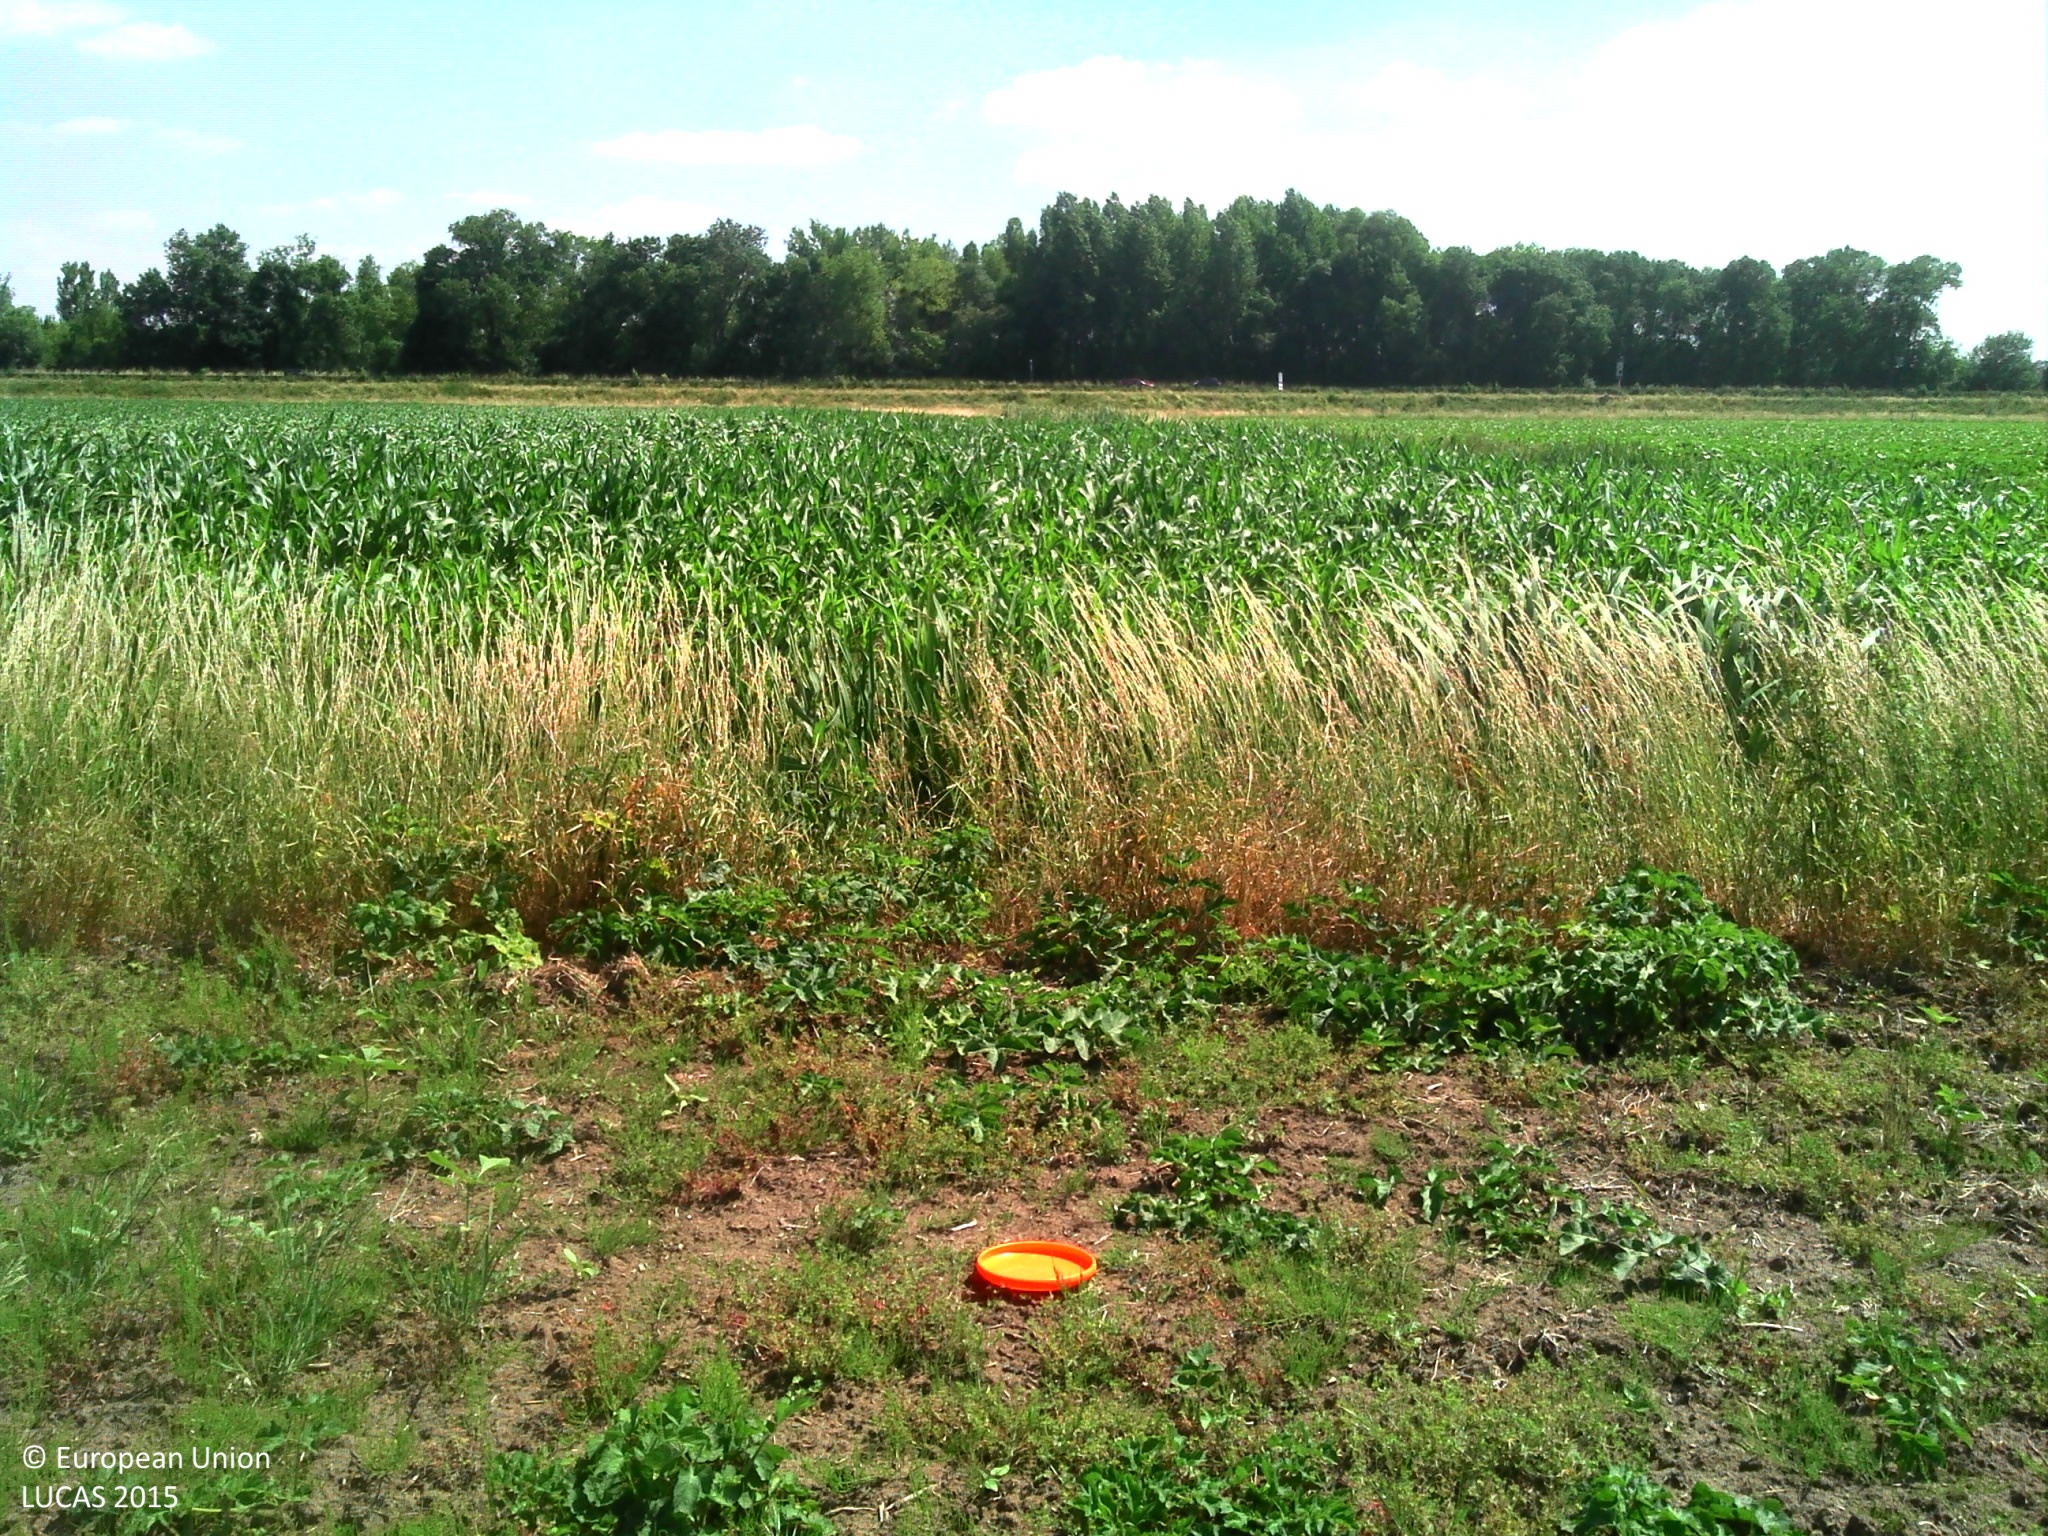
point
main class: Cropland
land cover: Sunflower
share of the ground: 10 - 25 %
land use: Agriculture (excluding fallow land and kitchen gardens)
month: June
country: FR
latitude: 47.3832
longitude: 0.7753
